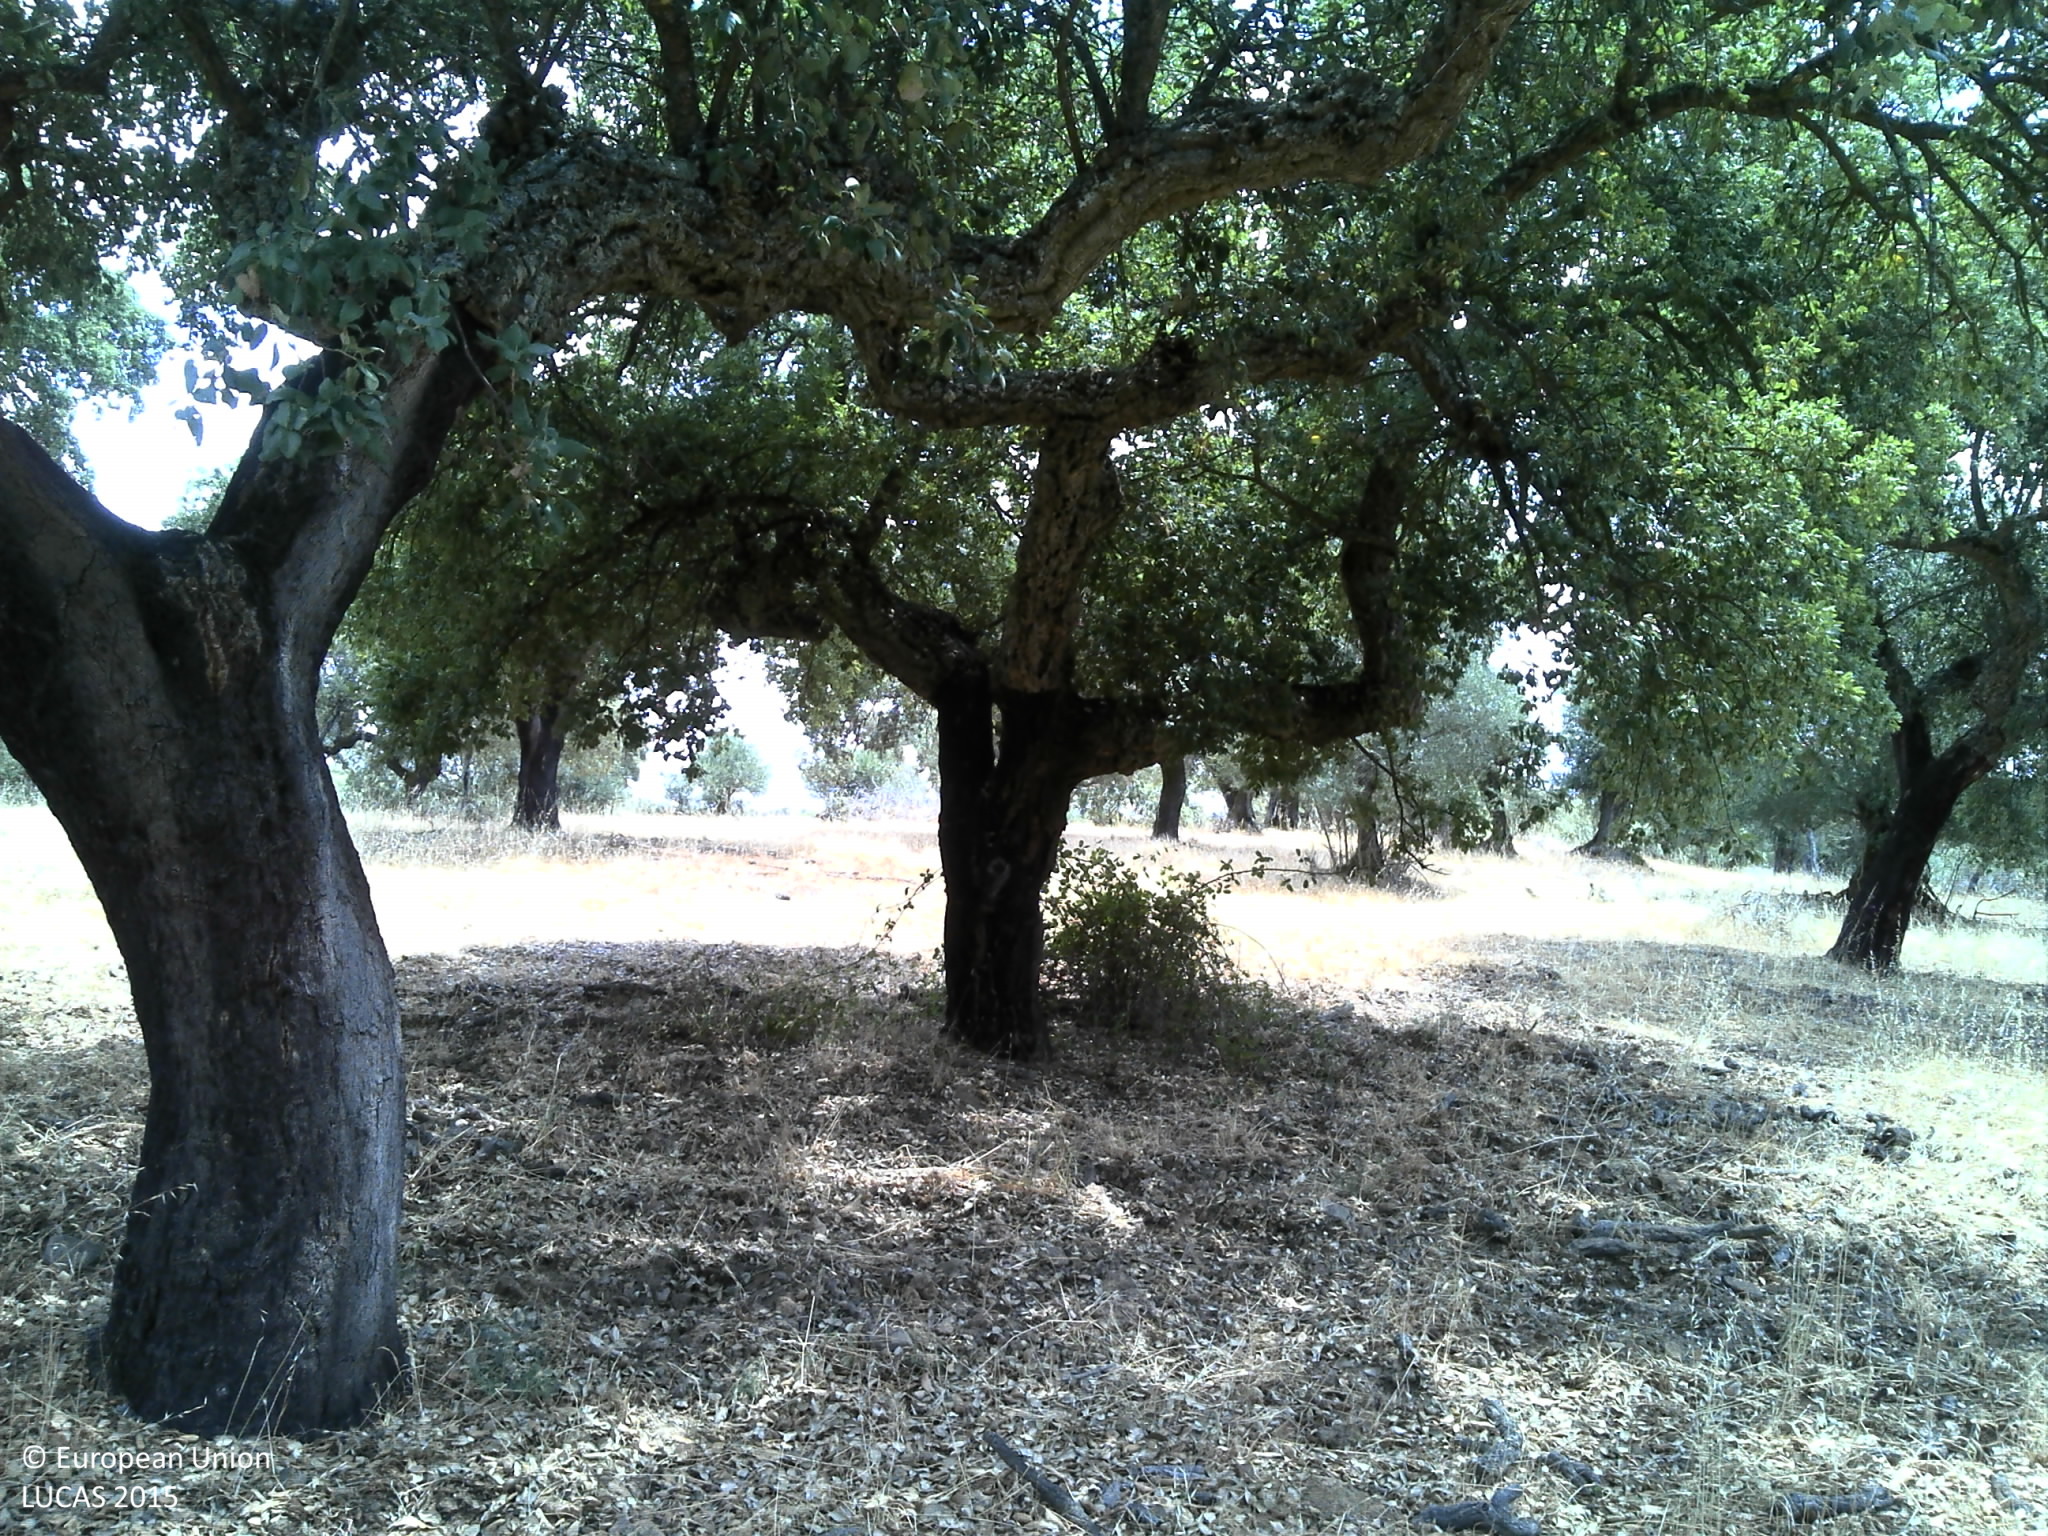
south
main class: Woodland
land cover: Broadleaved woodland
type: broadleaved evergreen forest
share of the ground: 50 - 75 %
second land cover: Grassland without tree/shrub cover
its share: 10 - 25 %
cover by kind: broadleaved forest trees 60 %, unconsolidated bare surface 25 %, herbaceous plants 15 %
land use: Forestry
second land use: Agriculture (excluding fallow land and kitchen gardens)
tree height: > 5 m
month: June
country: PT
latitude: 38.5246
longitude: -8.1328
